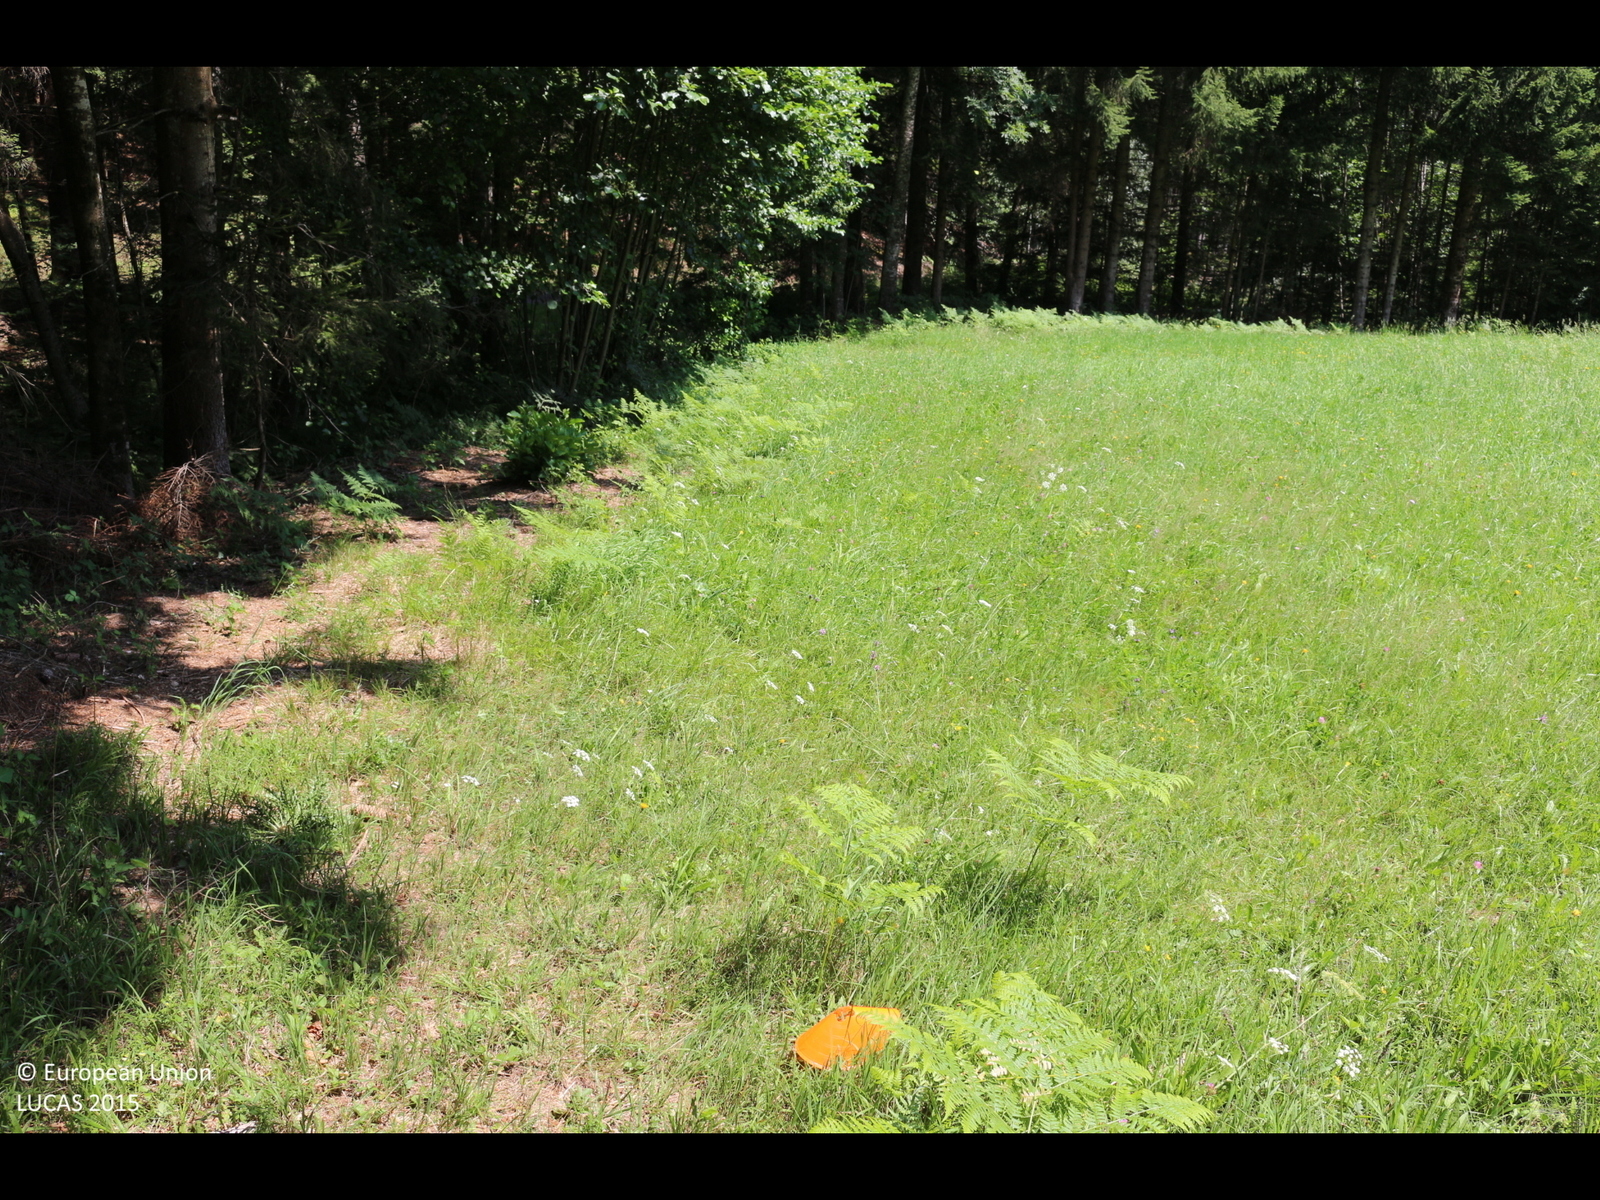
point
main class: Grassland
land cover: Grassland without tree/shrub cover
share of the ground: > 75 %
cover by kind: herbaceous plants 100 %
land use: Agriculture (excluding fallow land and kitchen gardens)
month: July
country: AT
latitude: 46.7423
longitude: 13.5705
